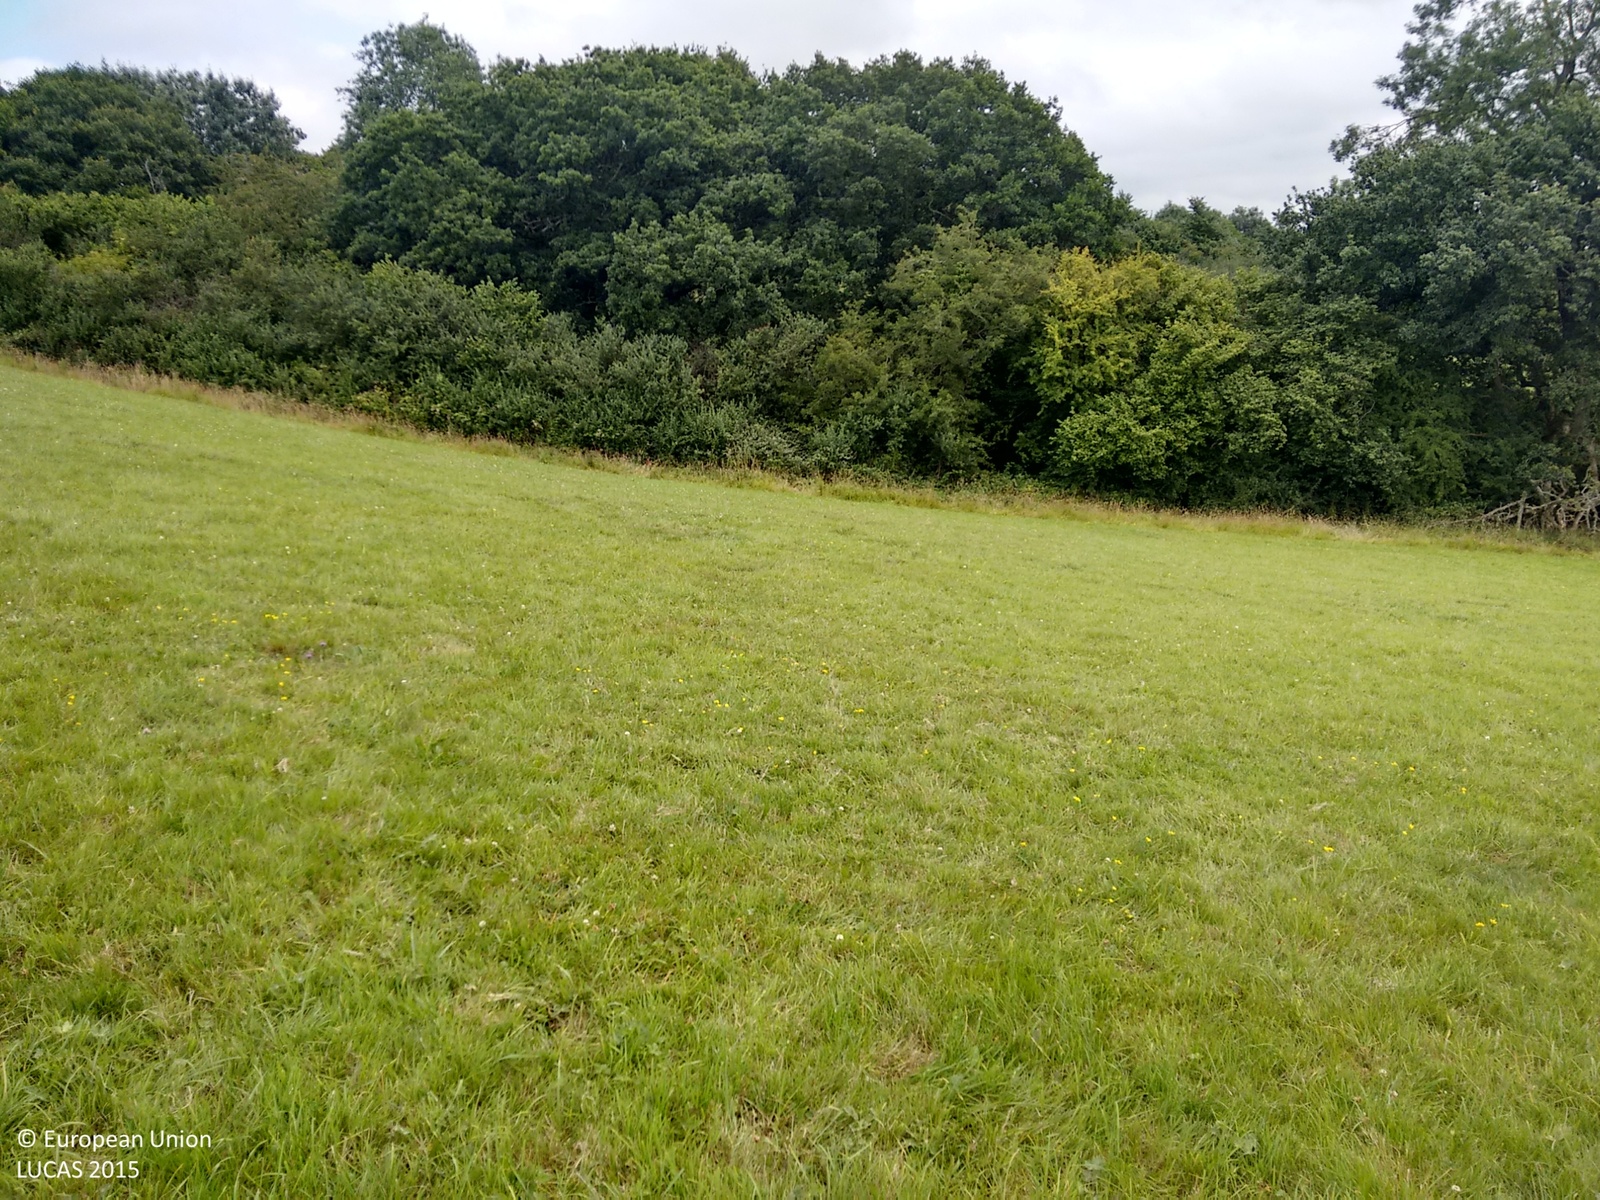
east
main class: Grassland
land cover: Grassland without tree/shrub cover
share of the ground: > 75 %
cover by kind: herbaceous plants 100 %
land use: Agriculture (excluding fallow land and kitchen gardens)
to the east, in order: Grassland without tree/shrub cover; Fences; Broadleaved woodland; Fences; Shrubland without tree cover; Fences; Grass margins; Fences; Broadleaved woodland; Fences; Broadleaved woodland
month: July
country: GB
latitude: 51.3832
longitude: -2.5245
